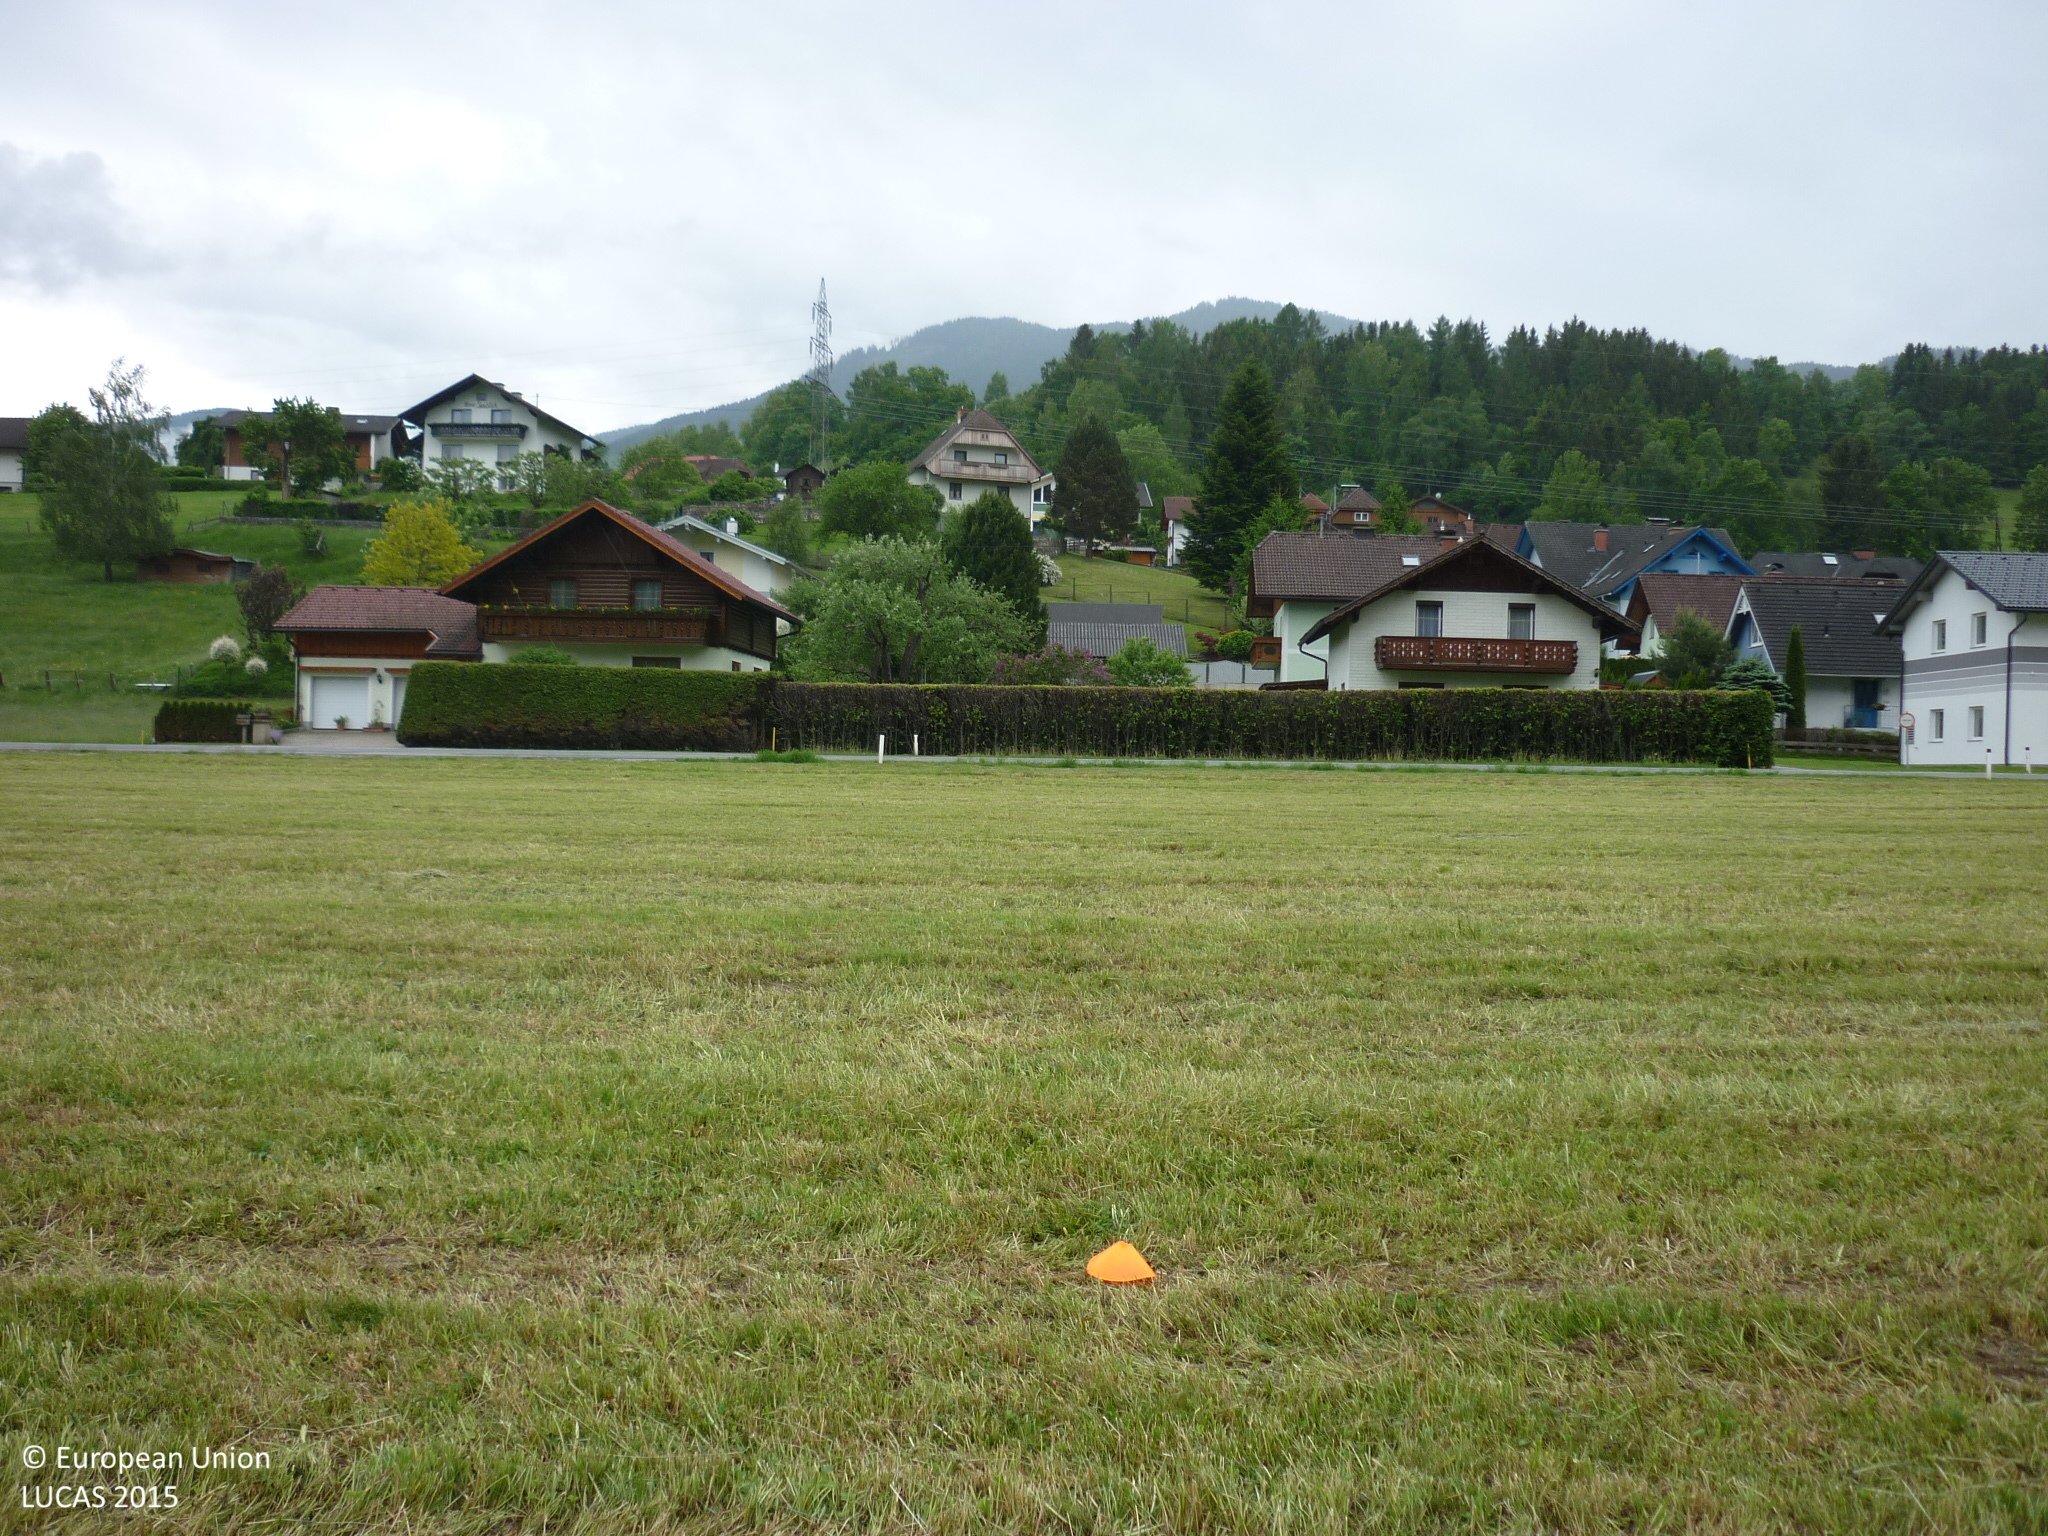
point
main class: Grassland
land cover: Grassland without tree/shrub cover
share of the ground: > 75 %
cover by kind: herbaceous plants 100 %
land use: Agriculture (excluding fallow land and kitchen gardens)
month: May
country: AT
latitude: 47.5155
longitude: 14.1286
